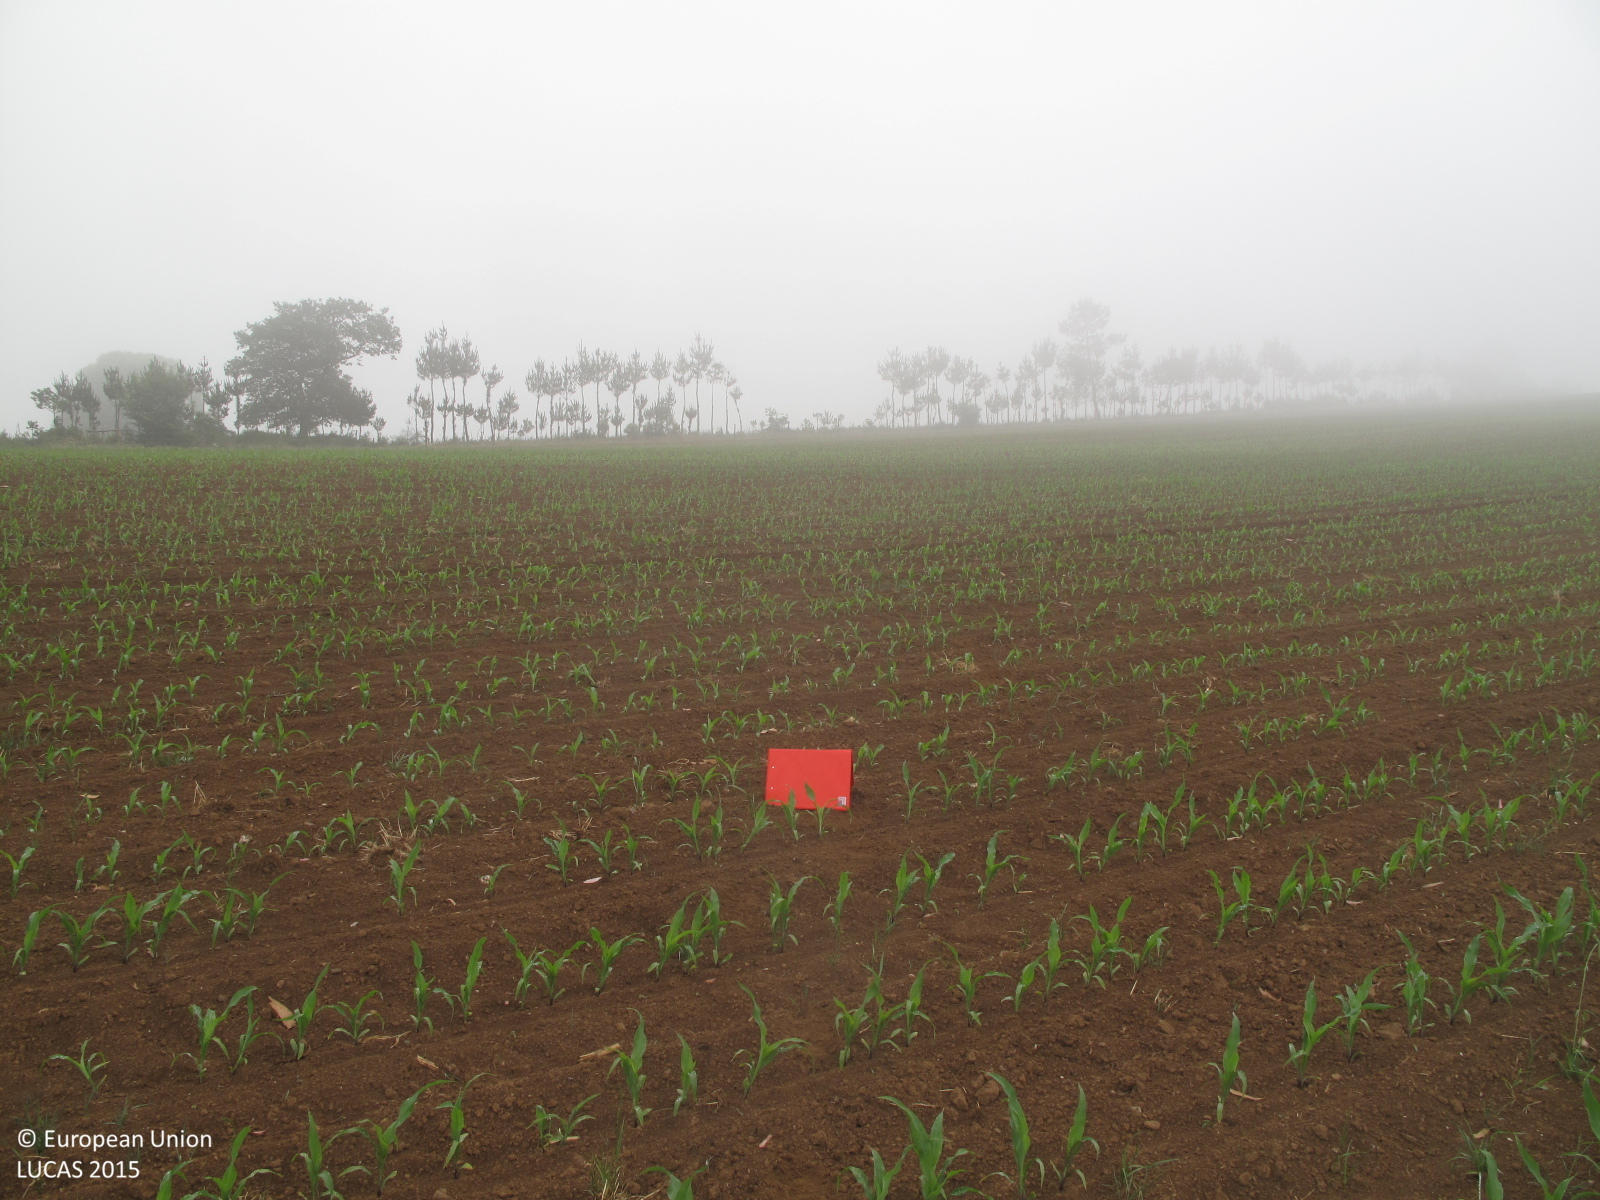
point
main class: Cropland
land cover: Maize
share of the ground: < 10 %
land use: Agriculture (excluding fallow land and kitchen gardens)
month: June
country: ES
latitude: 43.1294
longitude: -8.2046
